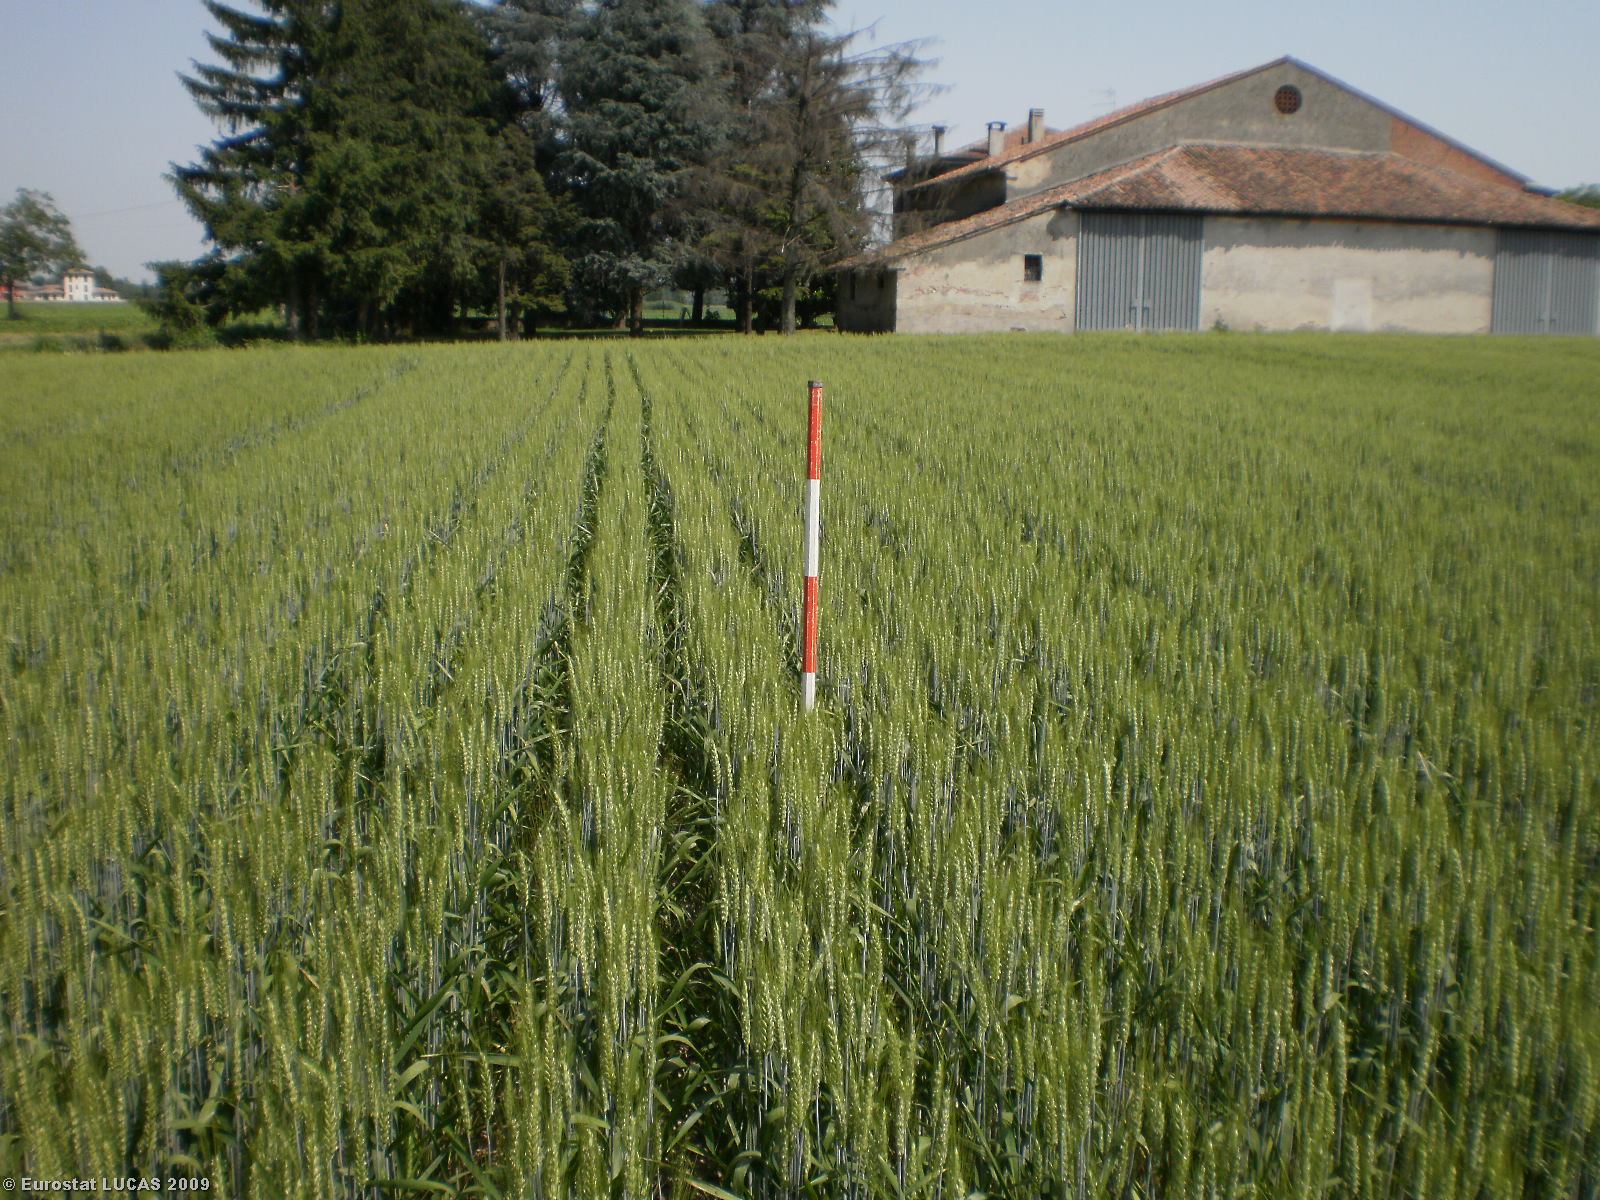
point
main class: Cropland
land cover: Common wheat
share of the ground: > 75 %
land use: Agriculture (excluding fallow land and kitchen gardens)
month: May
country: IT
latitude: 45.0690
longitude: 10.7733
